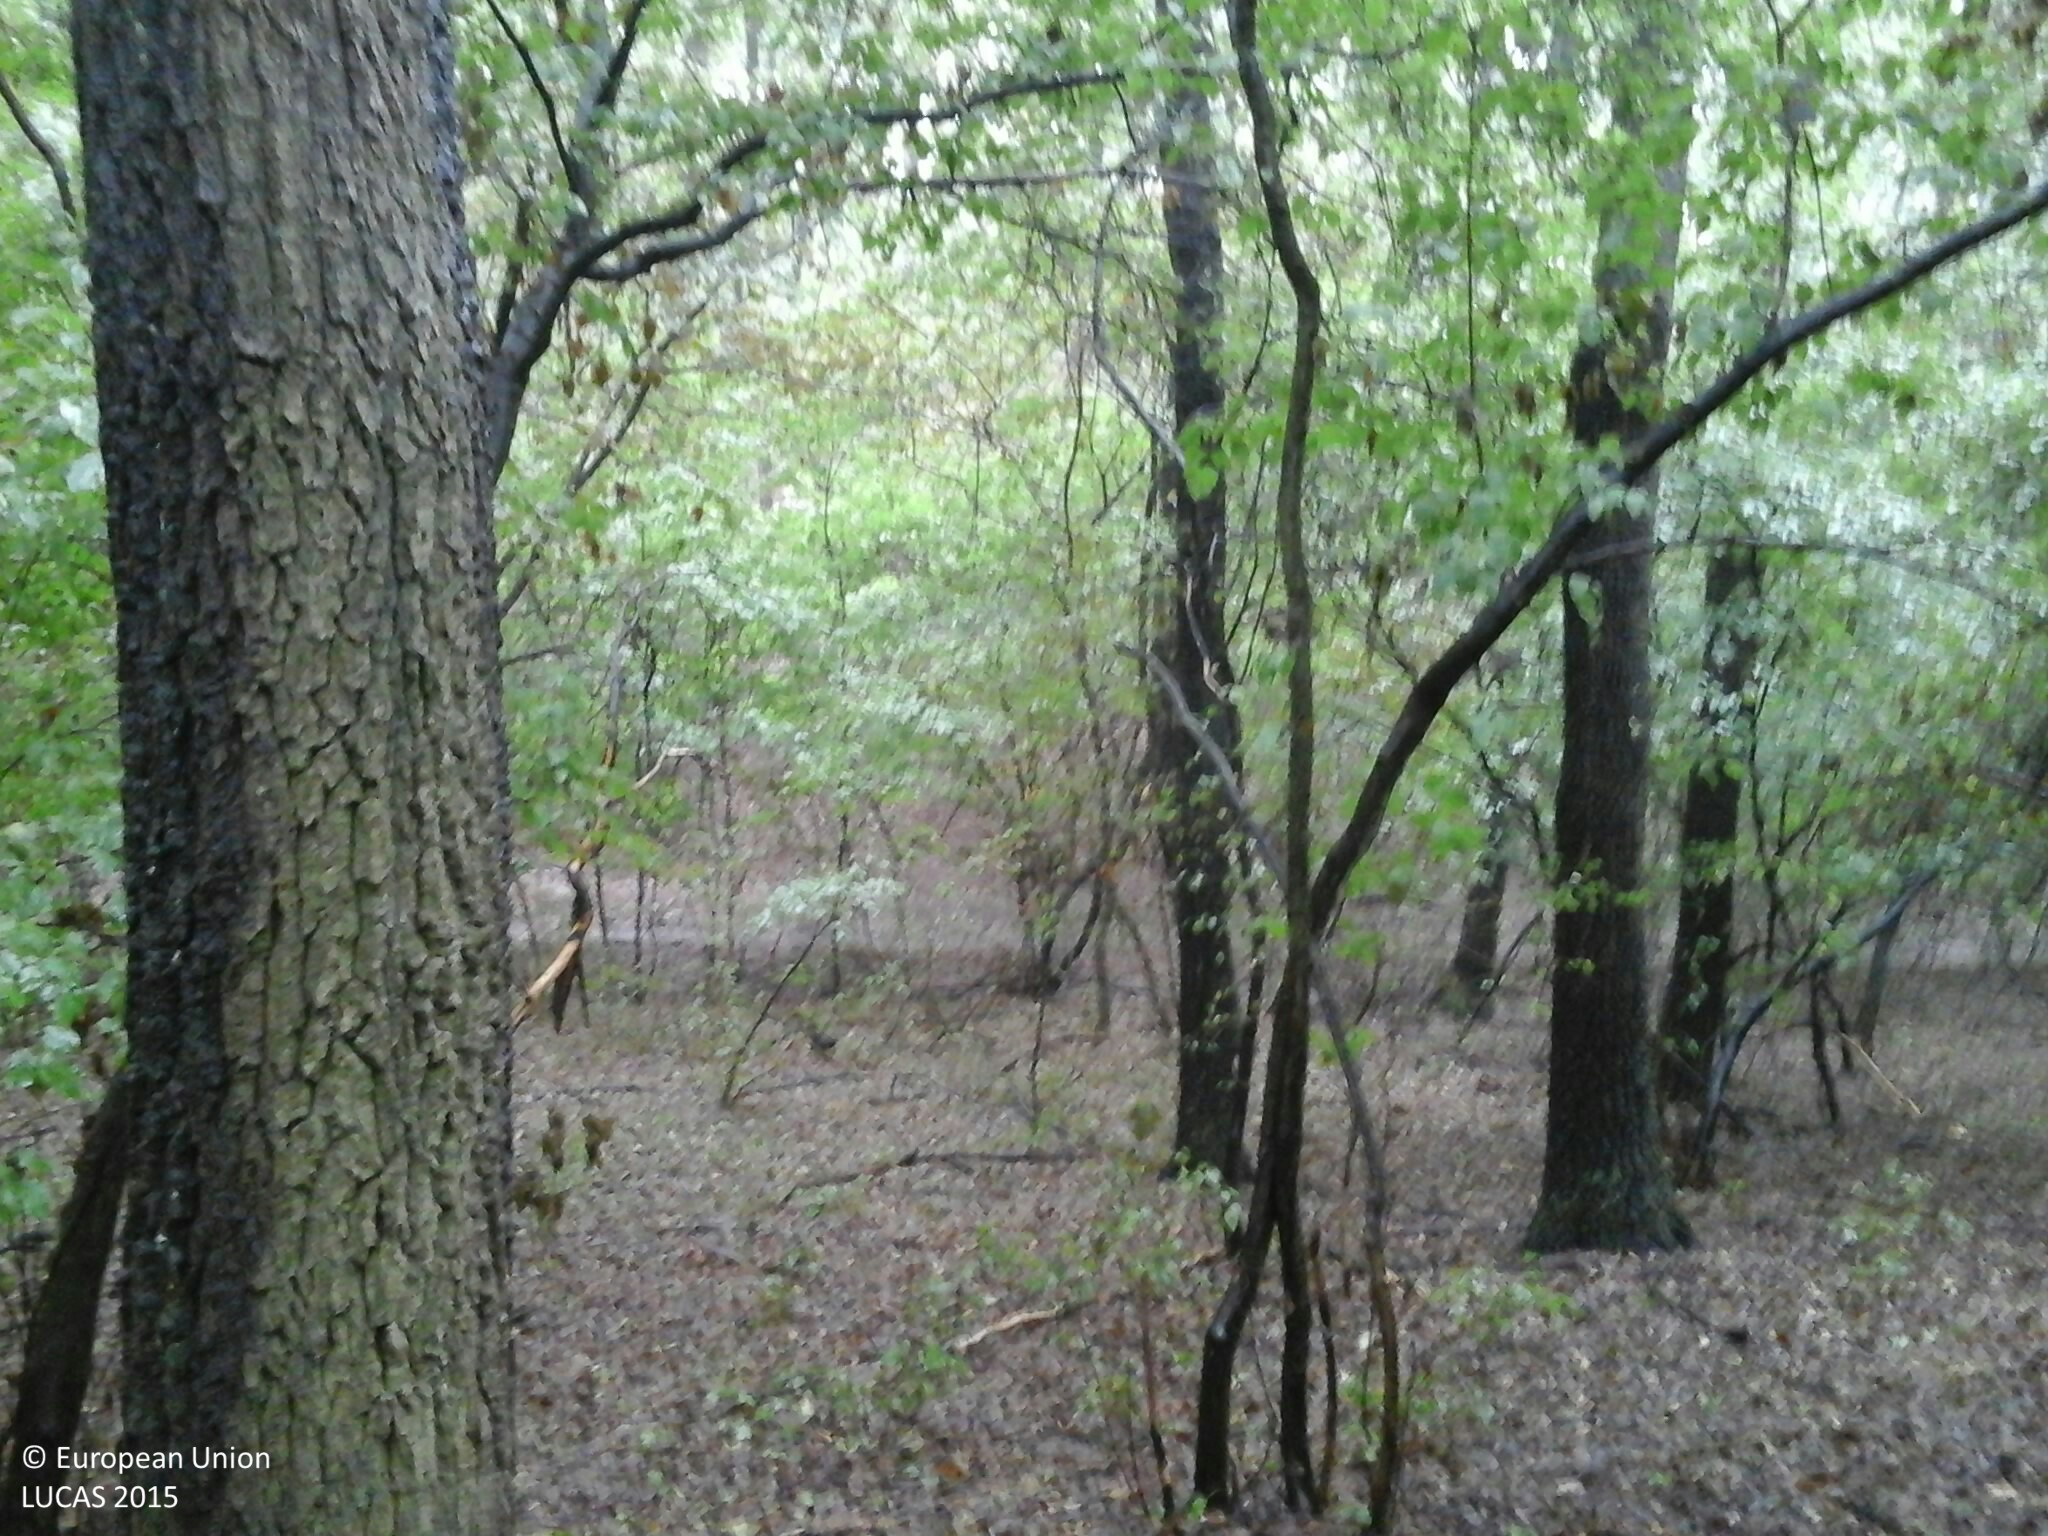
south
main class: Woodland
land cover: Broadleaved woodland
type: acidophilous oak and oak-birch forest
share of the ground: > 75 %
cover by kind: broadleaved forest trees 100 %
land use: Forestry
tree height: > 5 m
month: August
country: HU
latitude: 47.9723
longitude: 20.7115
